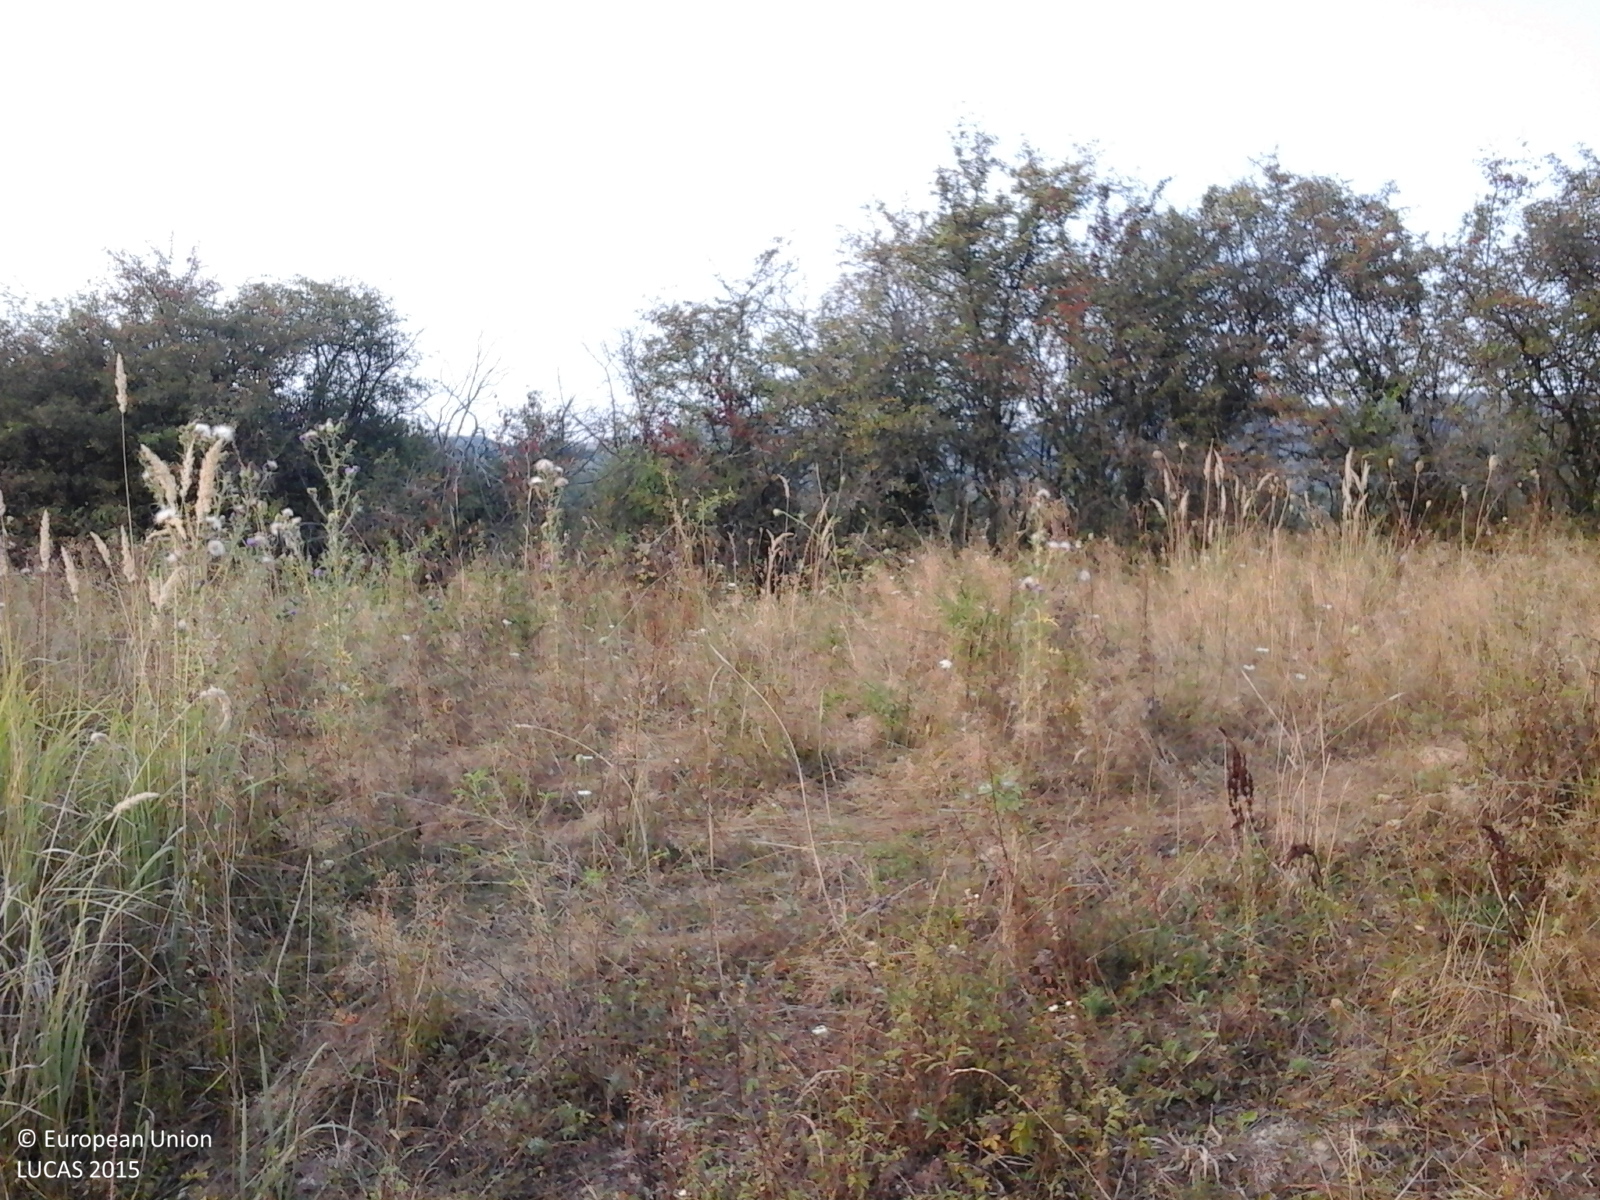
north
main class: Grassland
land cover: Spontaneously vegetated surfaces
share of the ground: > 75 %
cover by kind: herbaceous plants 100 %
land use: Fallow land
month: September
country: RO
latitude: 47.2885
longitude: 24.2750
